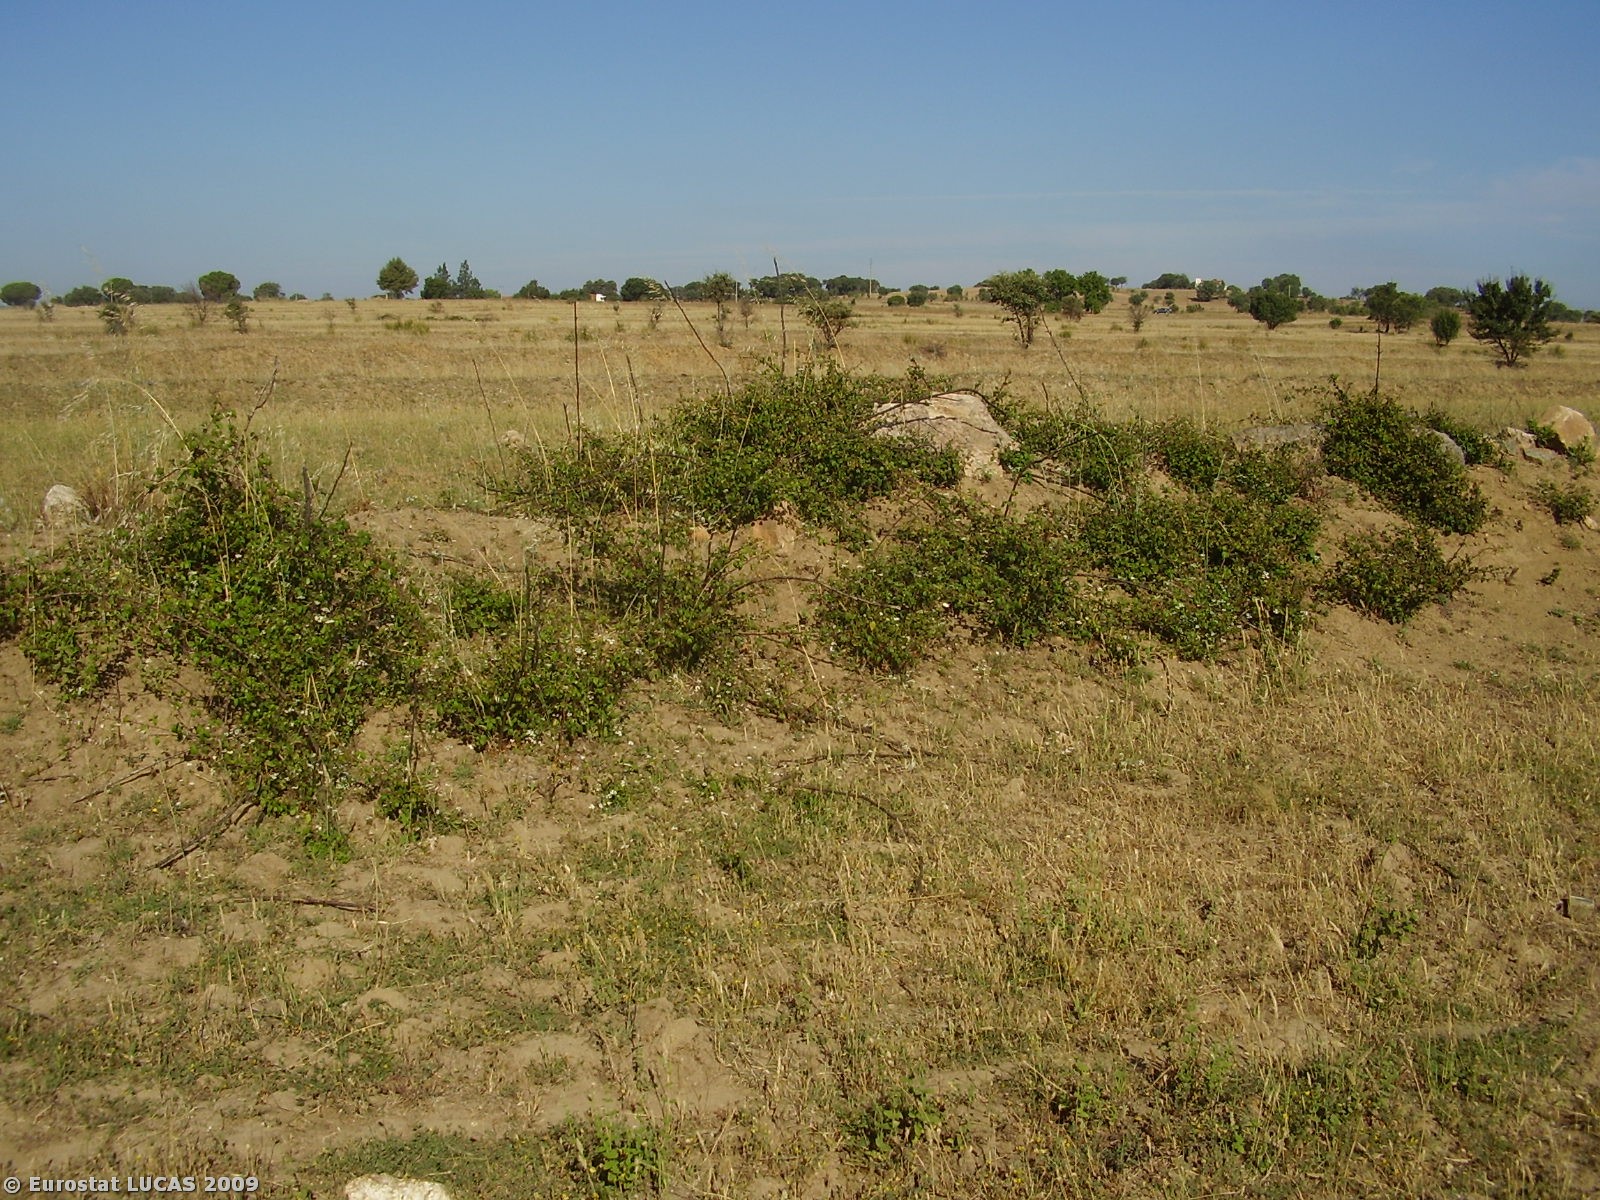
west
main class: Grassland
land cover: Spontaneously vegetated surfaces
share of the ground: > 75 %
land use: Fallow land
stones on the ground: 10 - 25 %
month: July
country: PT
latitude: 38.7471
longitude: -7.9351
